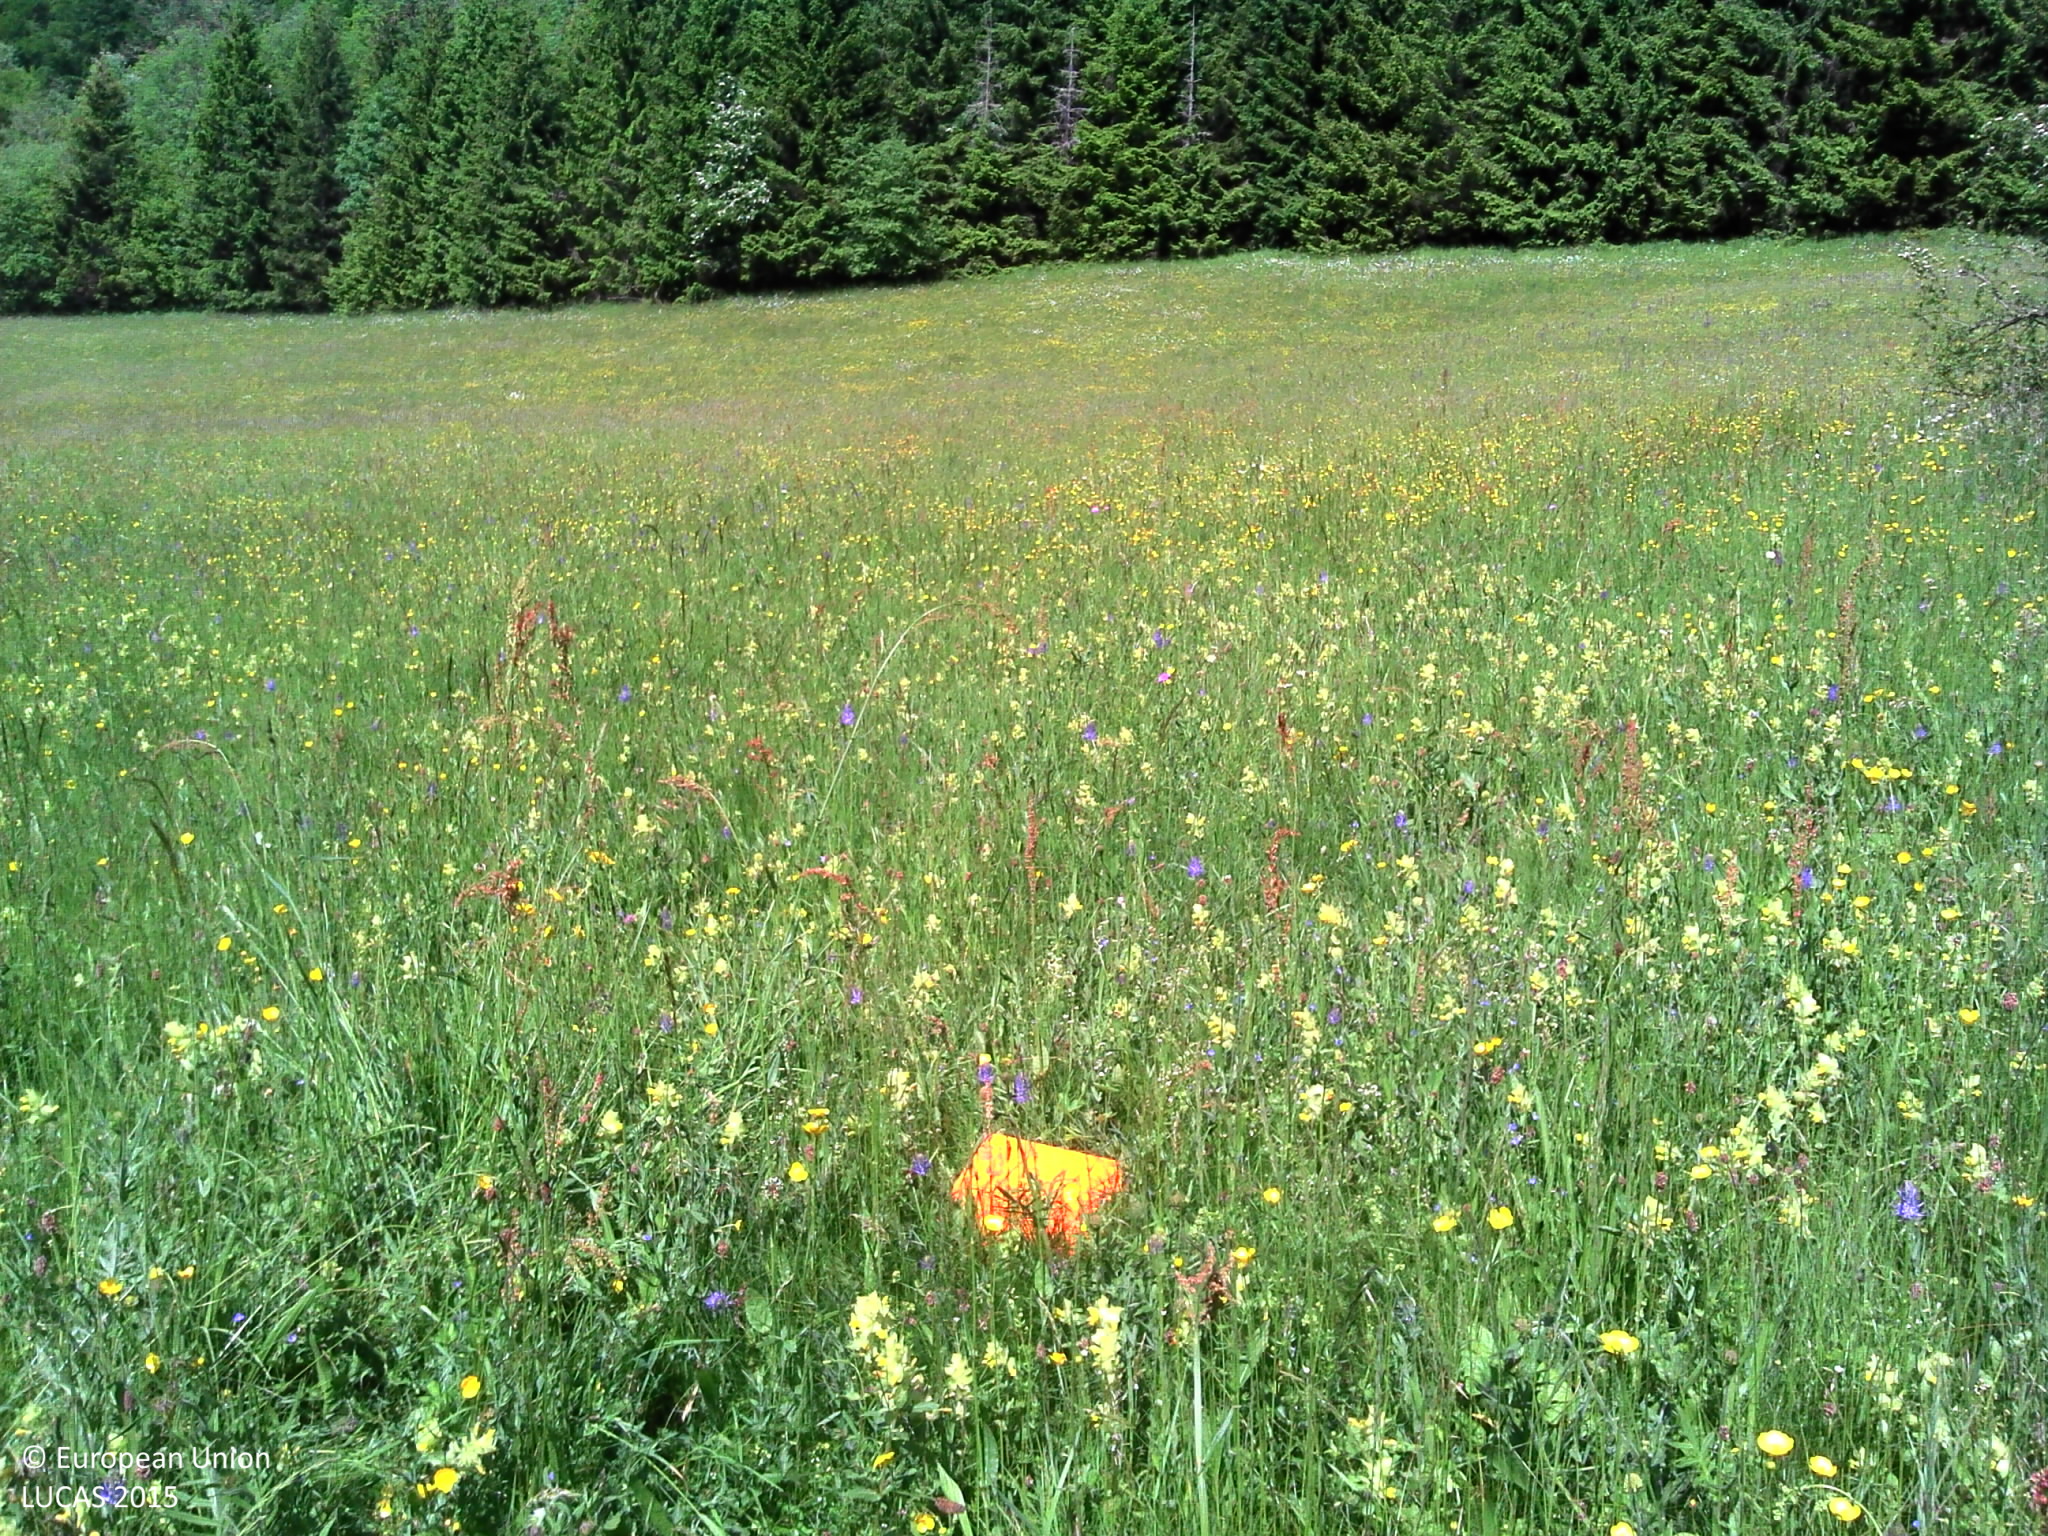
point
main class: Grassland
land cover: Grassland without tree/shrub cover
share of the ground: > 75 %
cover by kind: herbaceous plants 100 %
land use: Agriculture (excluding fallow land and kitchen gardens)
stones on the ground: < 10 %
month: June
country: FR
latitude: 44.9811
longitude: 5.2248
